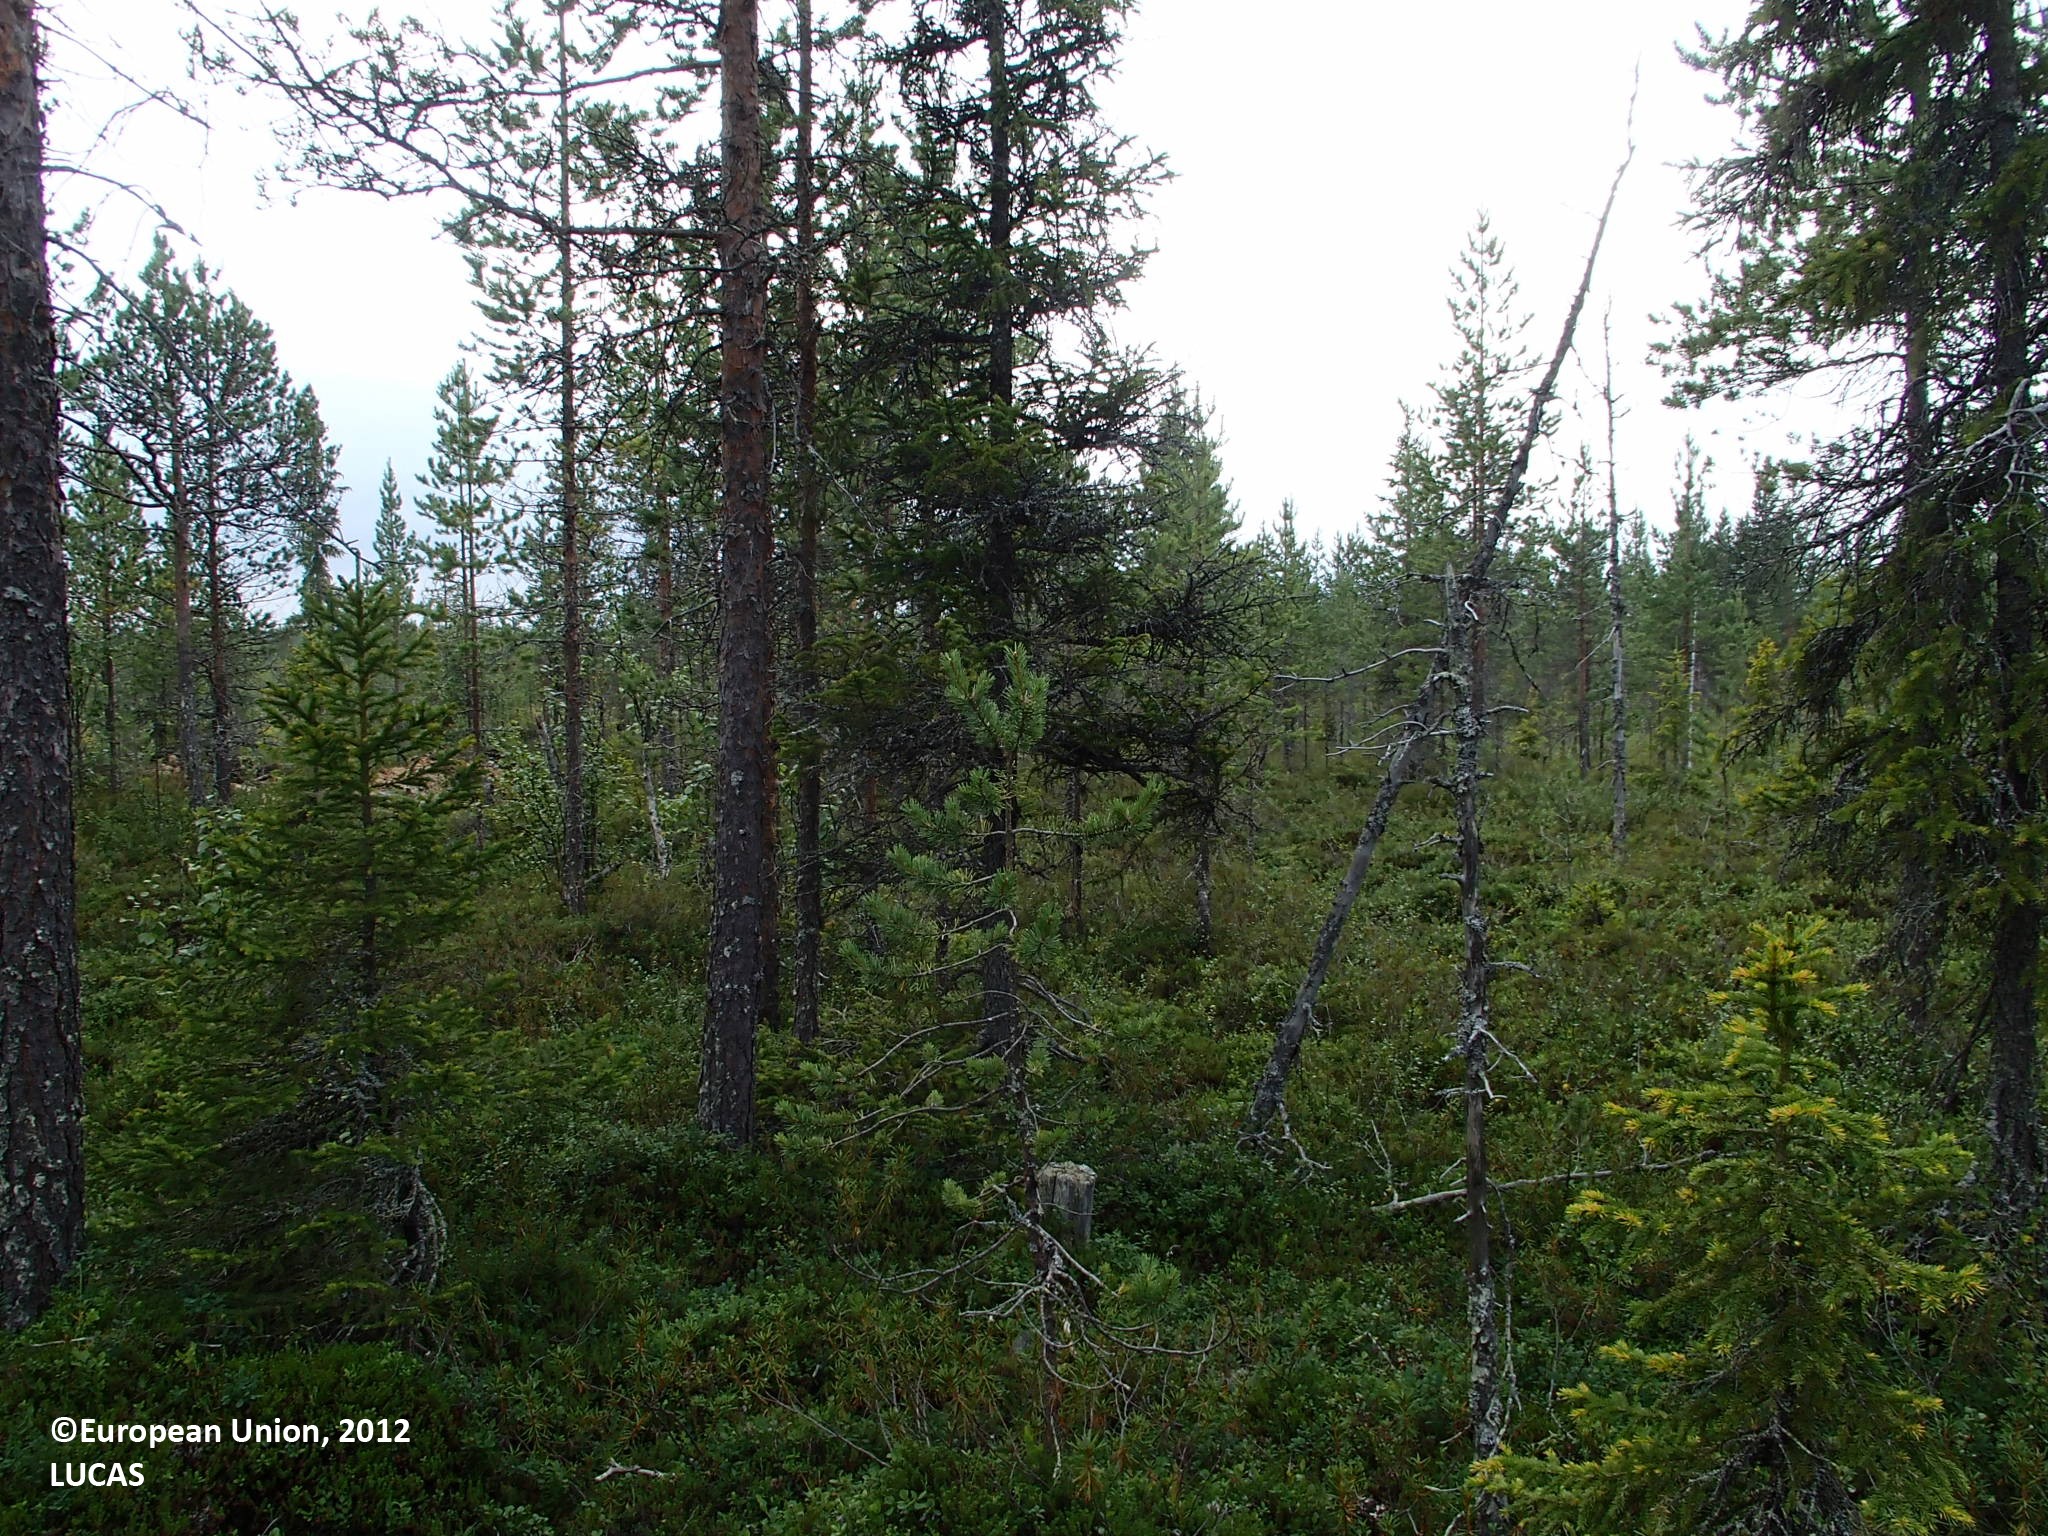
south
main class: Woodland
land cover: Other coniferous woodland
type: boreal forest
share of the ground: 50 - 75 %
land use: Forestry
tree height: > 5 m
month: July
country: FI
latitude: 66.1614
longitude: 25.3428
